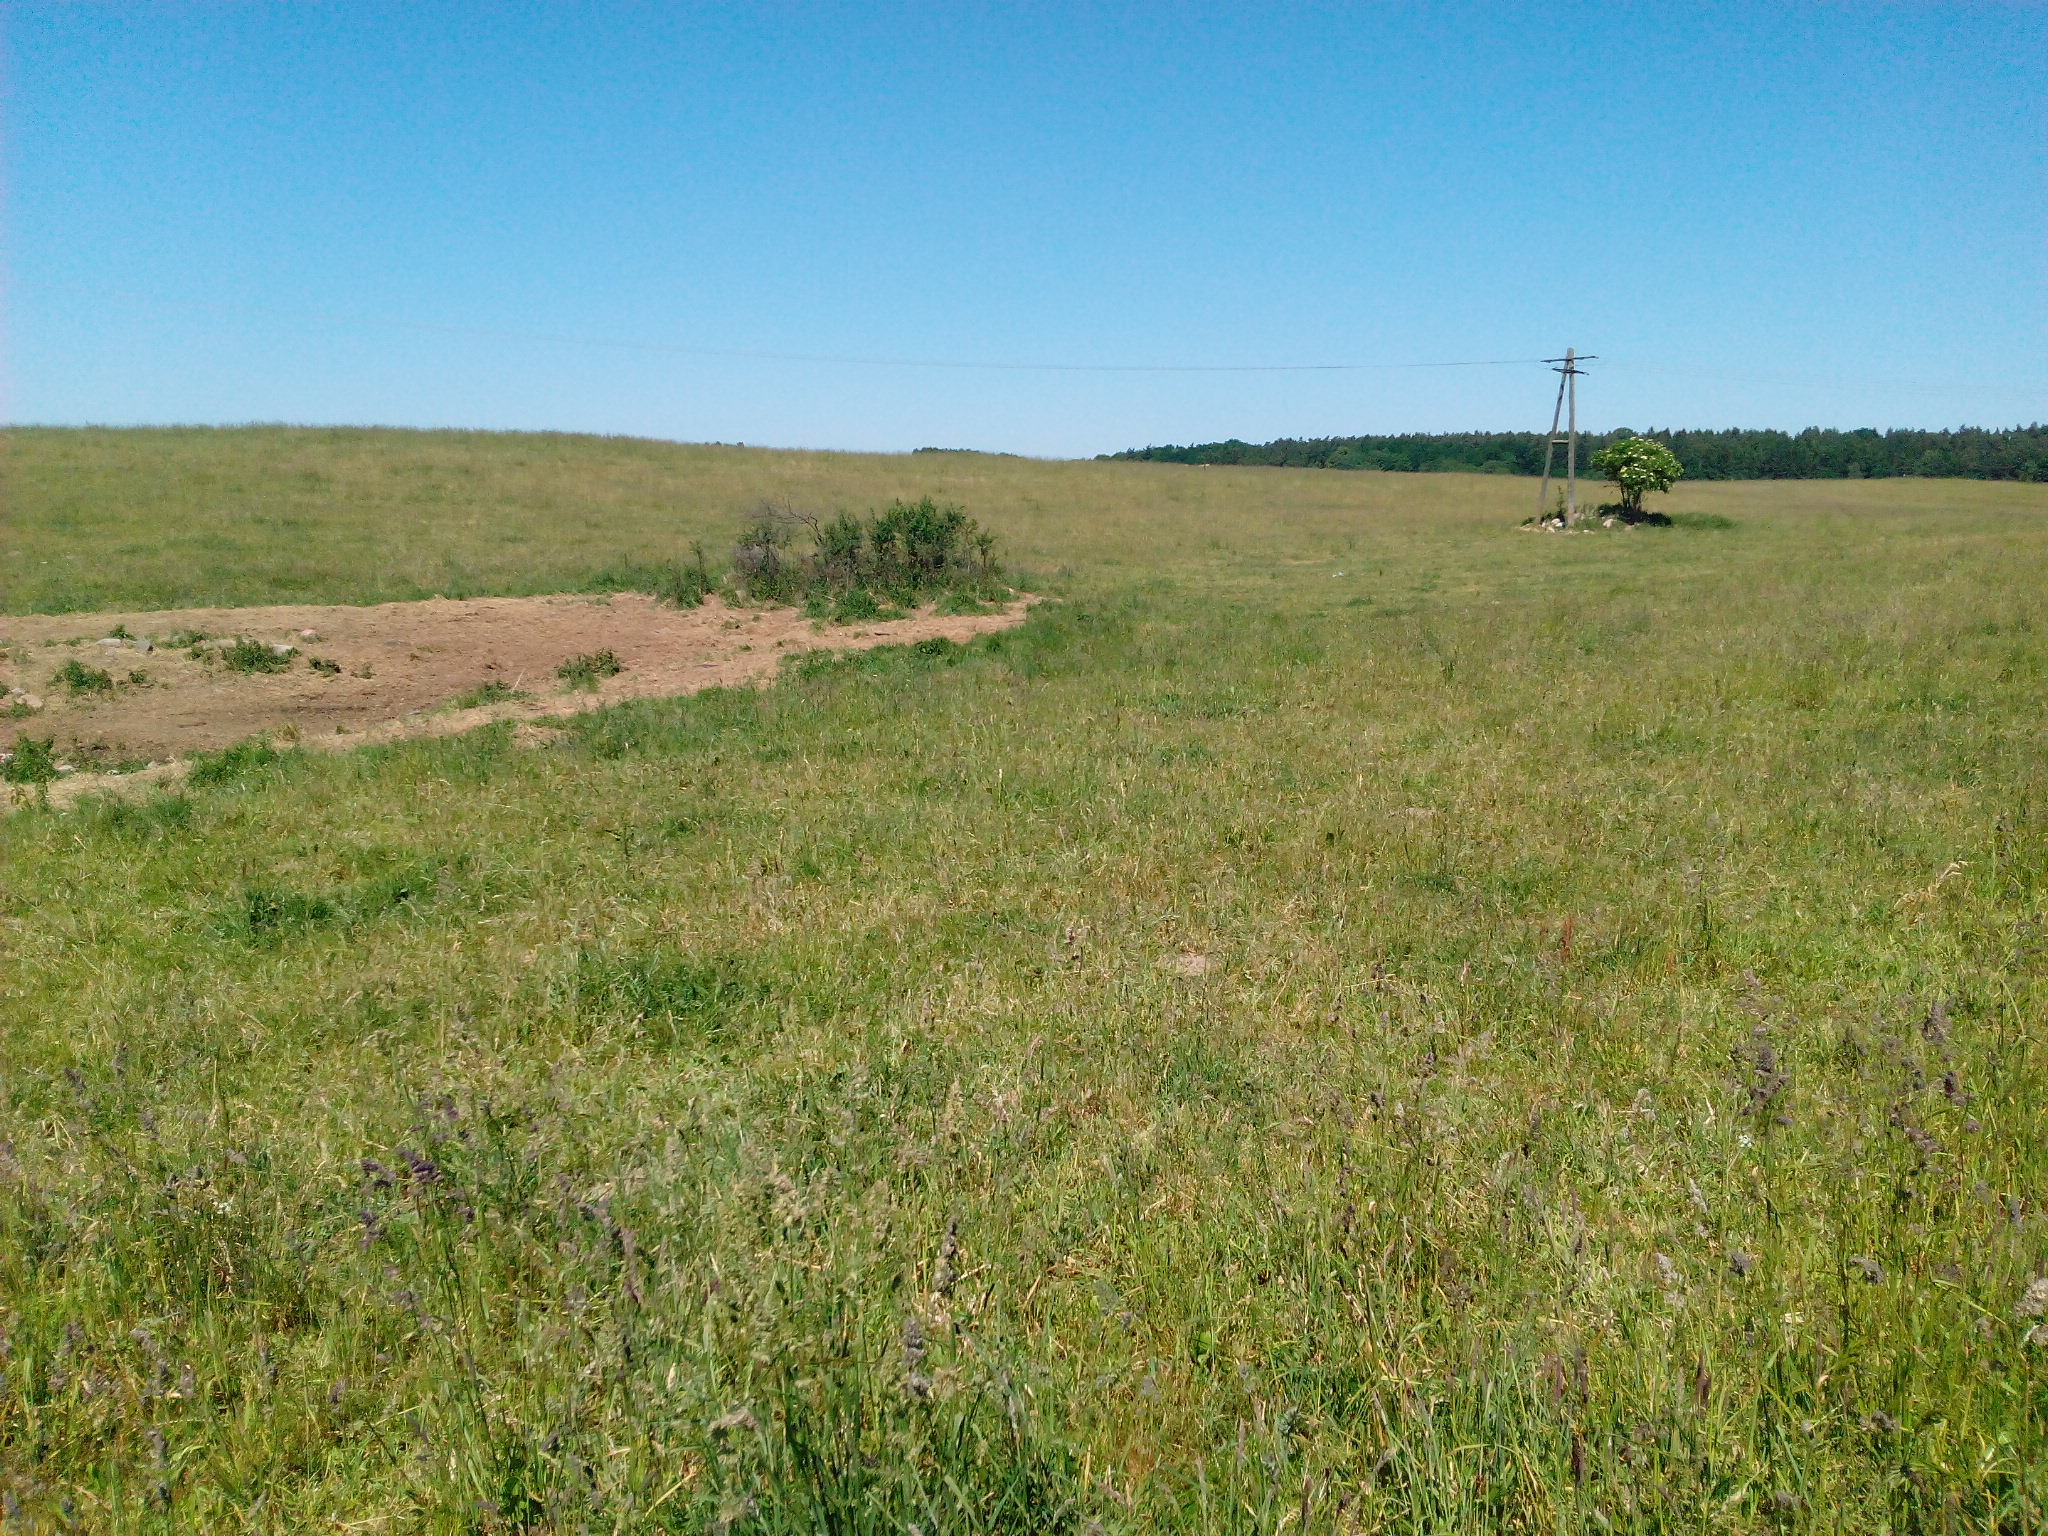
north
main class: Grassland
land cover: Grassland without tree/shrub cover
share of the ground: > 75 %
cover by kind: herbaceous plants 95 %, shrubs 5 %
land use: Agriculture (excluding fallow land and kitchen gardens)
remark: Harvested field
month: June
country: DE
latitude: 53.1693
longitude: 13.5753
